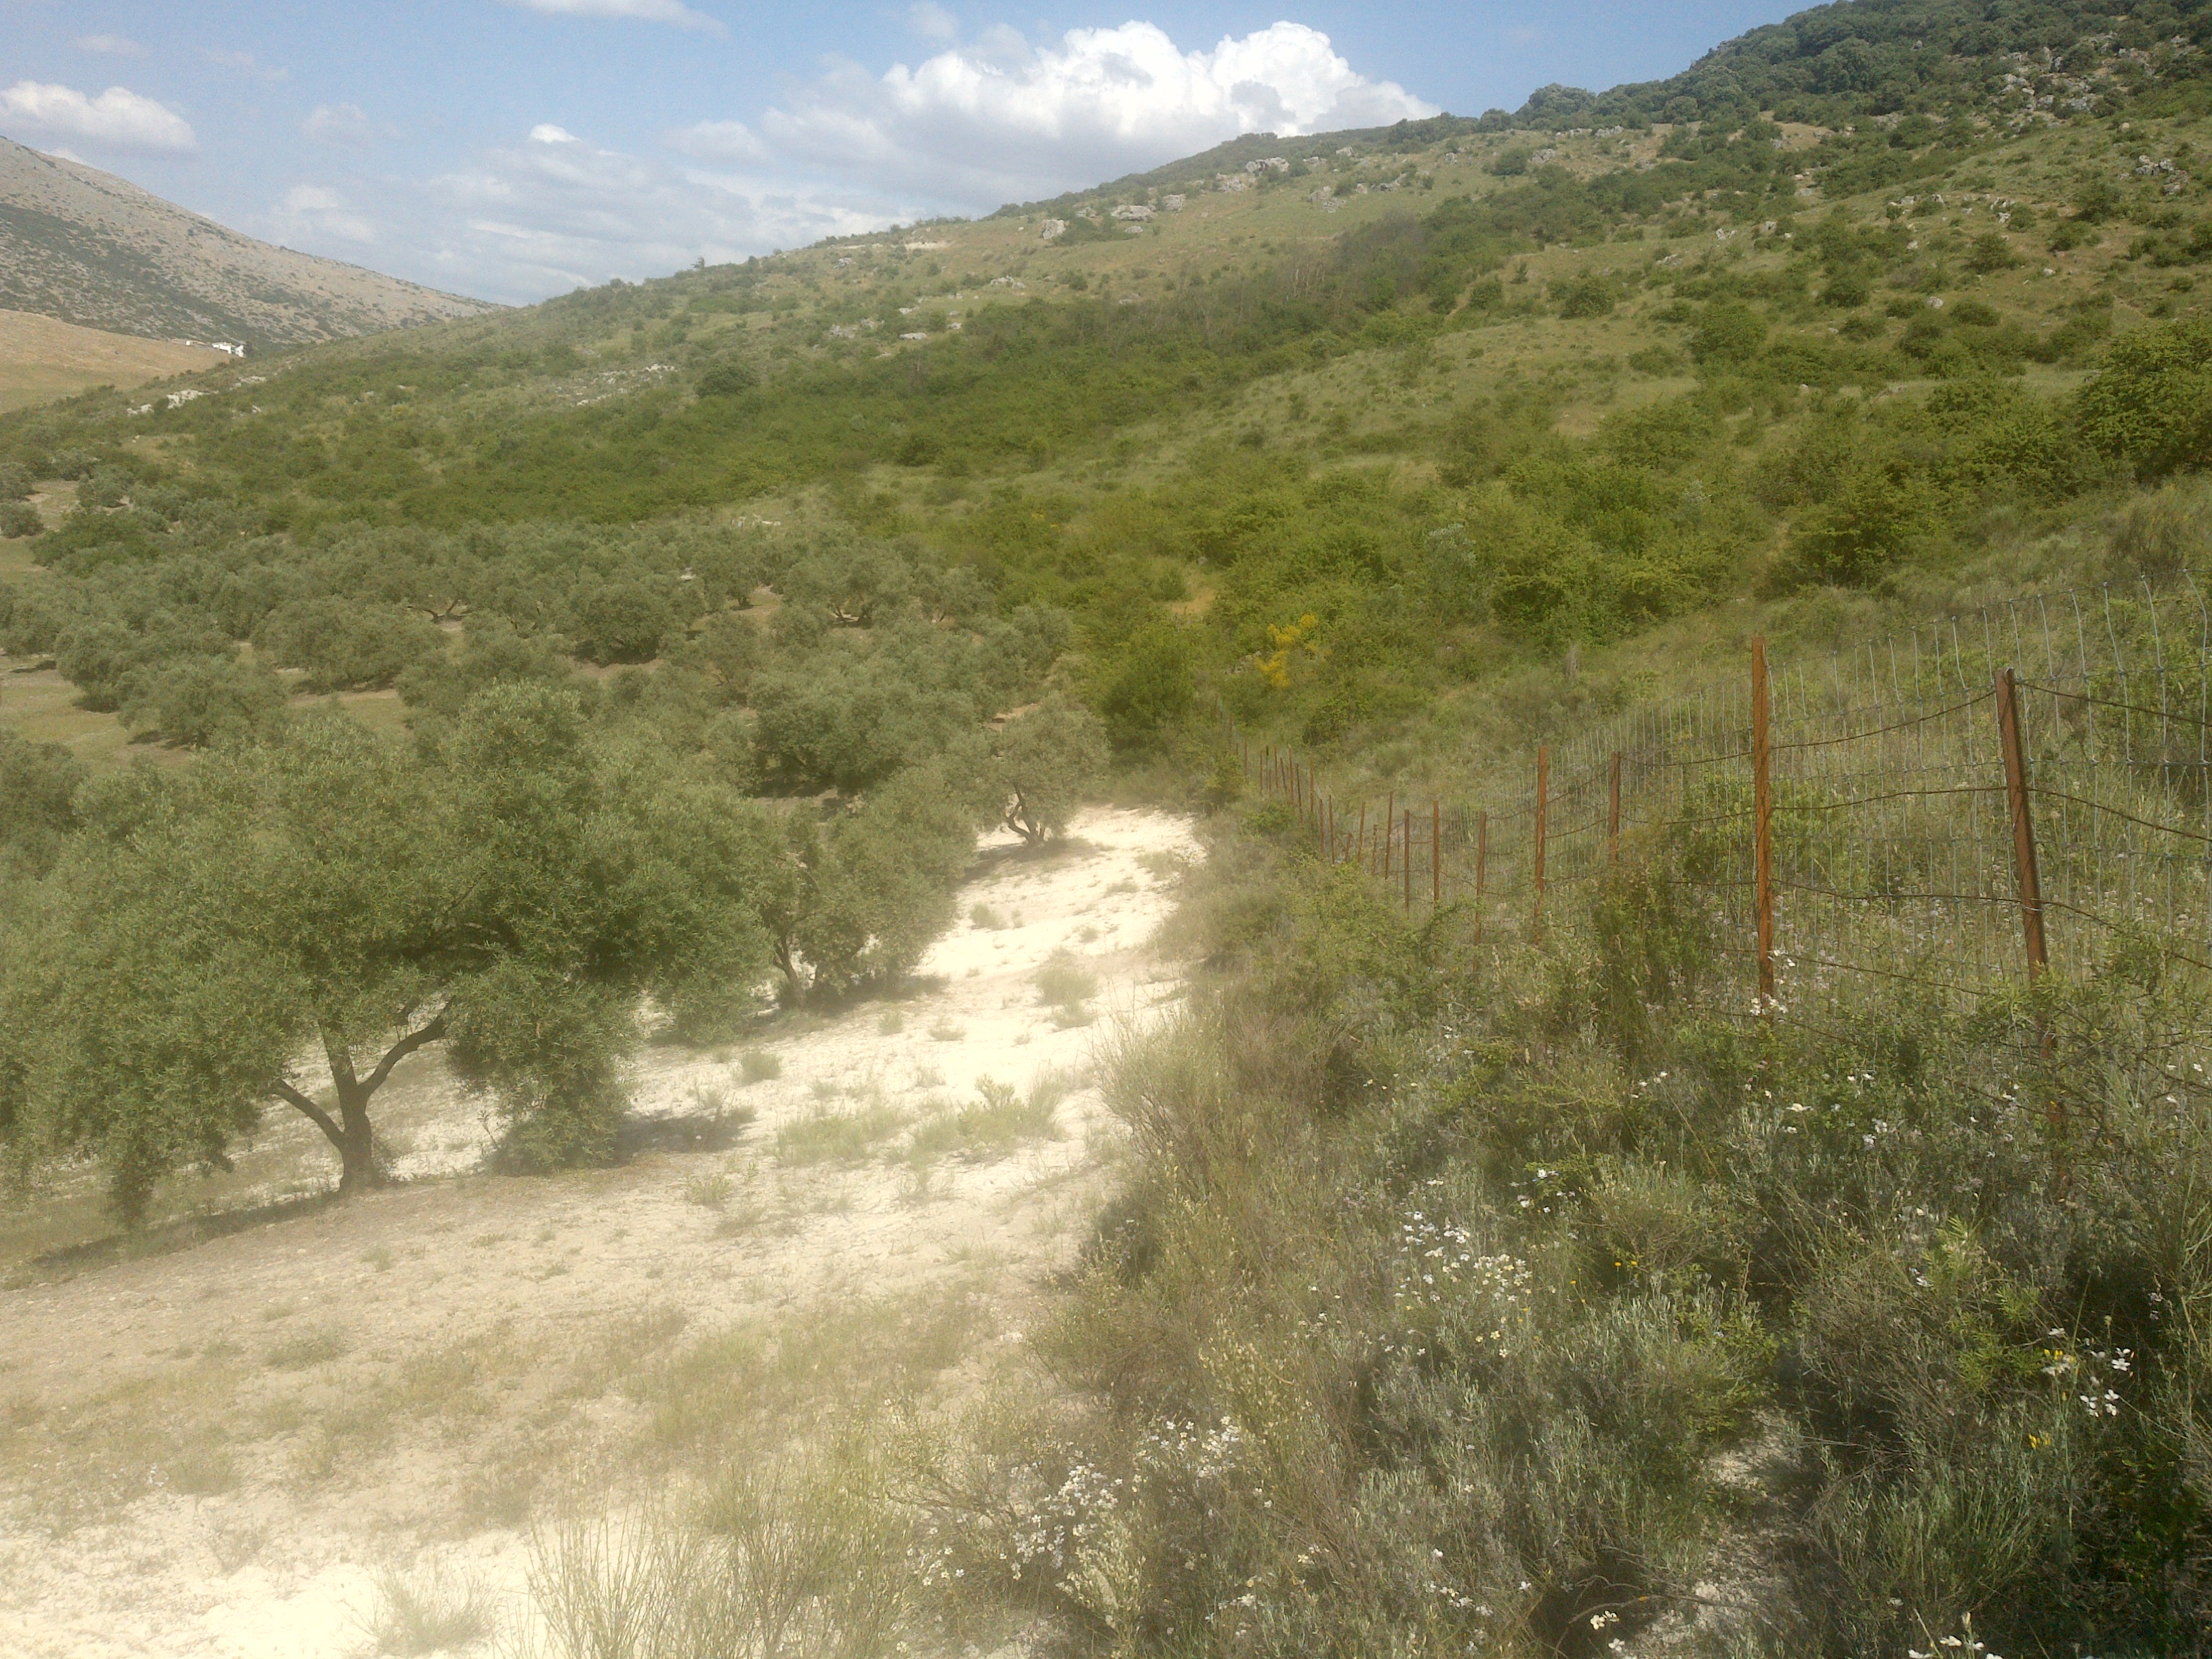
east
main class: Shrubland
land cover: Shrubland without tree cover
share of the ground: > 75 %
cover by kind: shrubs 75 %, herbaceous plants 20 %, unconsolidated bare surface 5 %
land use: Semi-natural and natural areas not in use
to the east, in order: Shrubland without tree cover
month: May
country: ES
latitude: 37.4587
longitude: -4.3711
